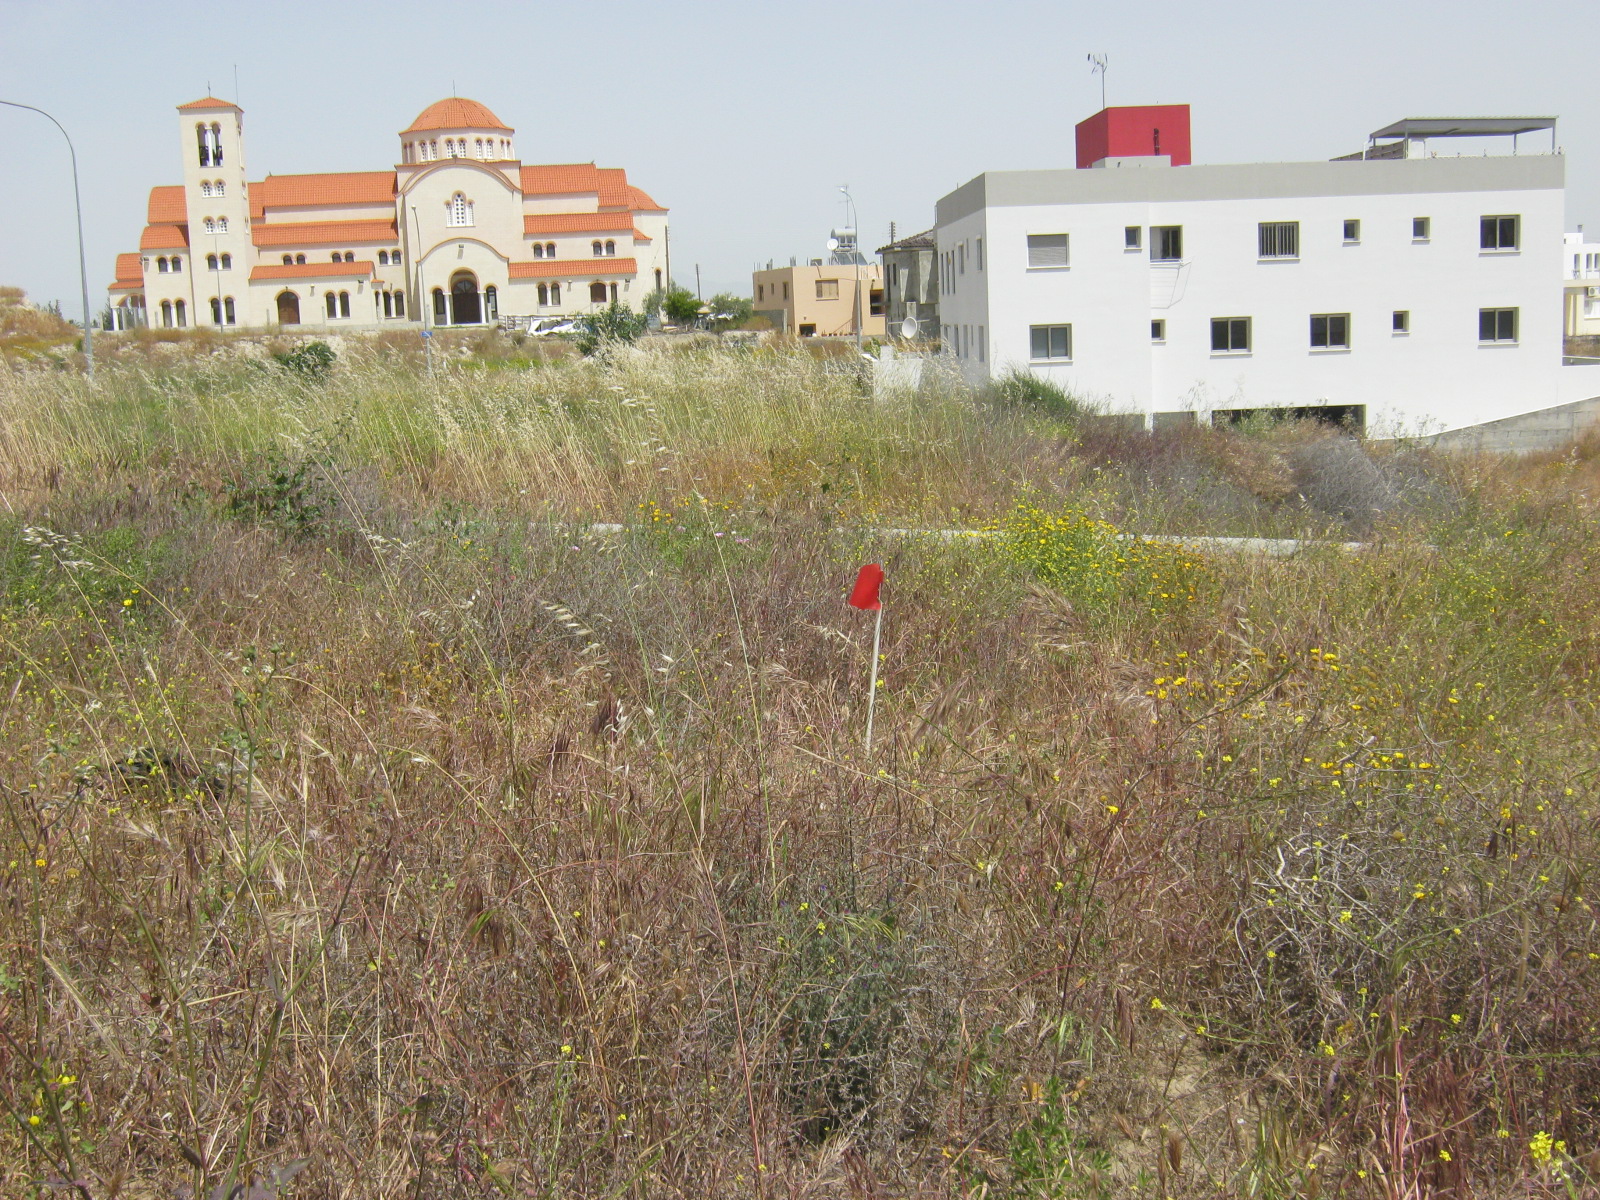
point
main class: Grassland
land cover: Spontaneously vegetated surfaces
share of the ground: > 75 %
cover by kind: herbaceous plants 100 %
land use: Residential
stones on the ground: 10 - 25 %
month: April
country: CY
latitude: 35.0700
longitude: 33.3849
